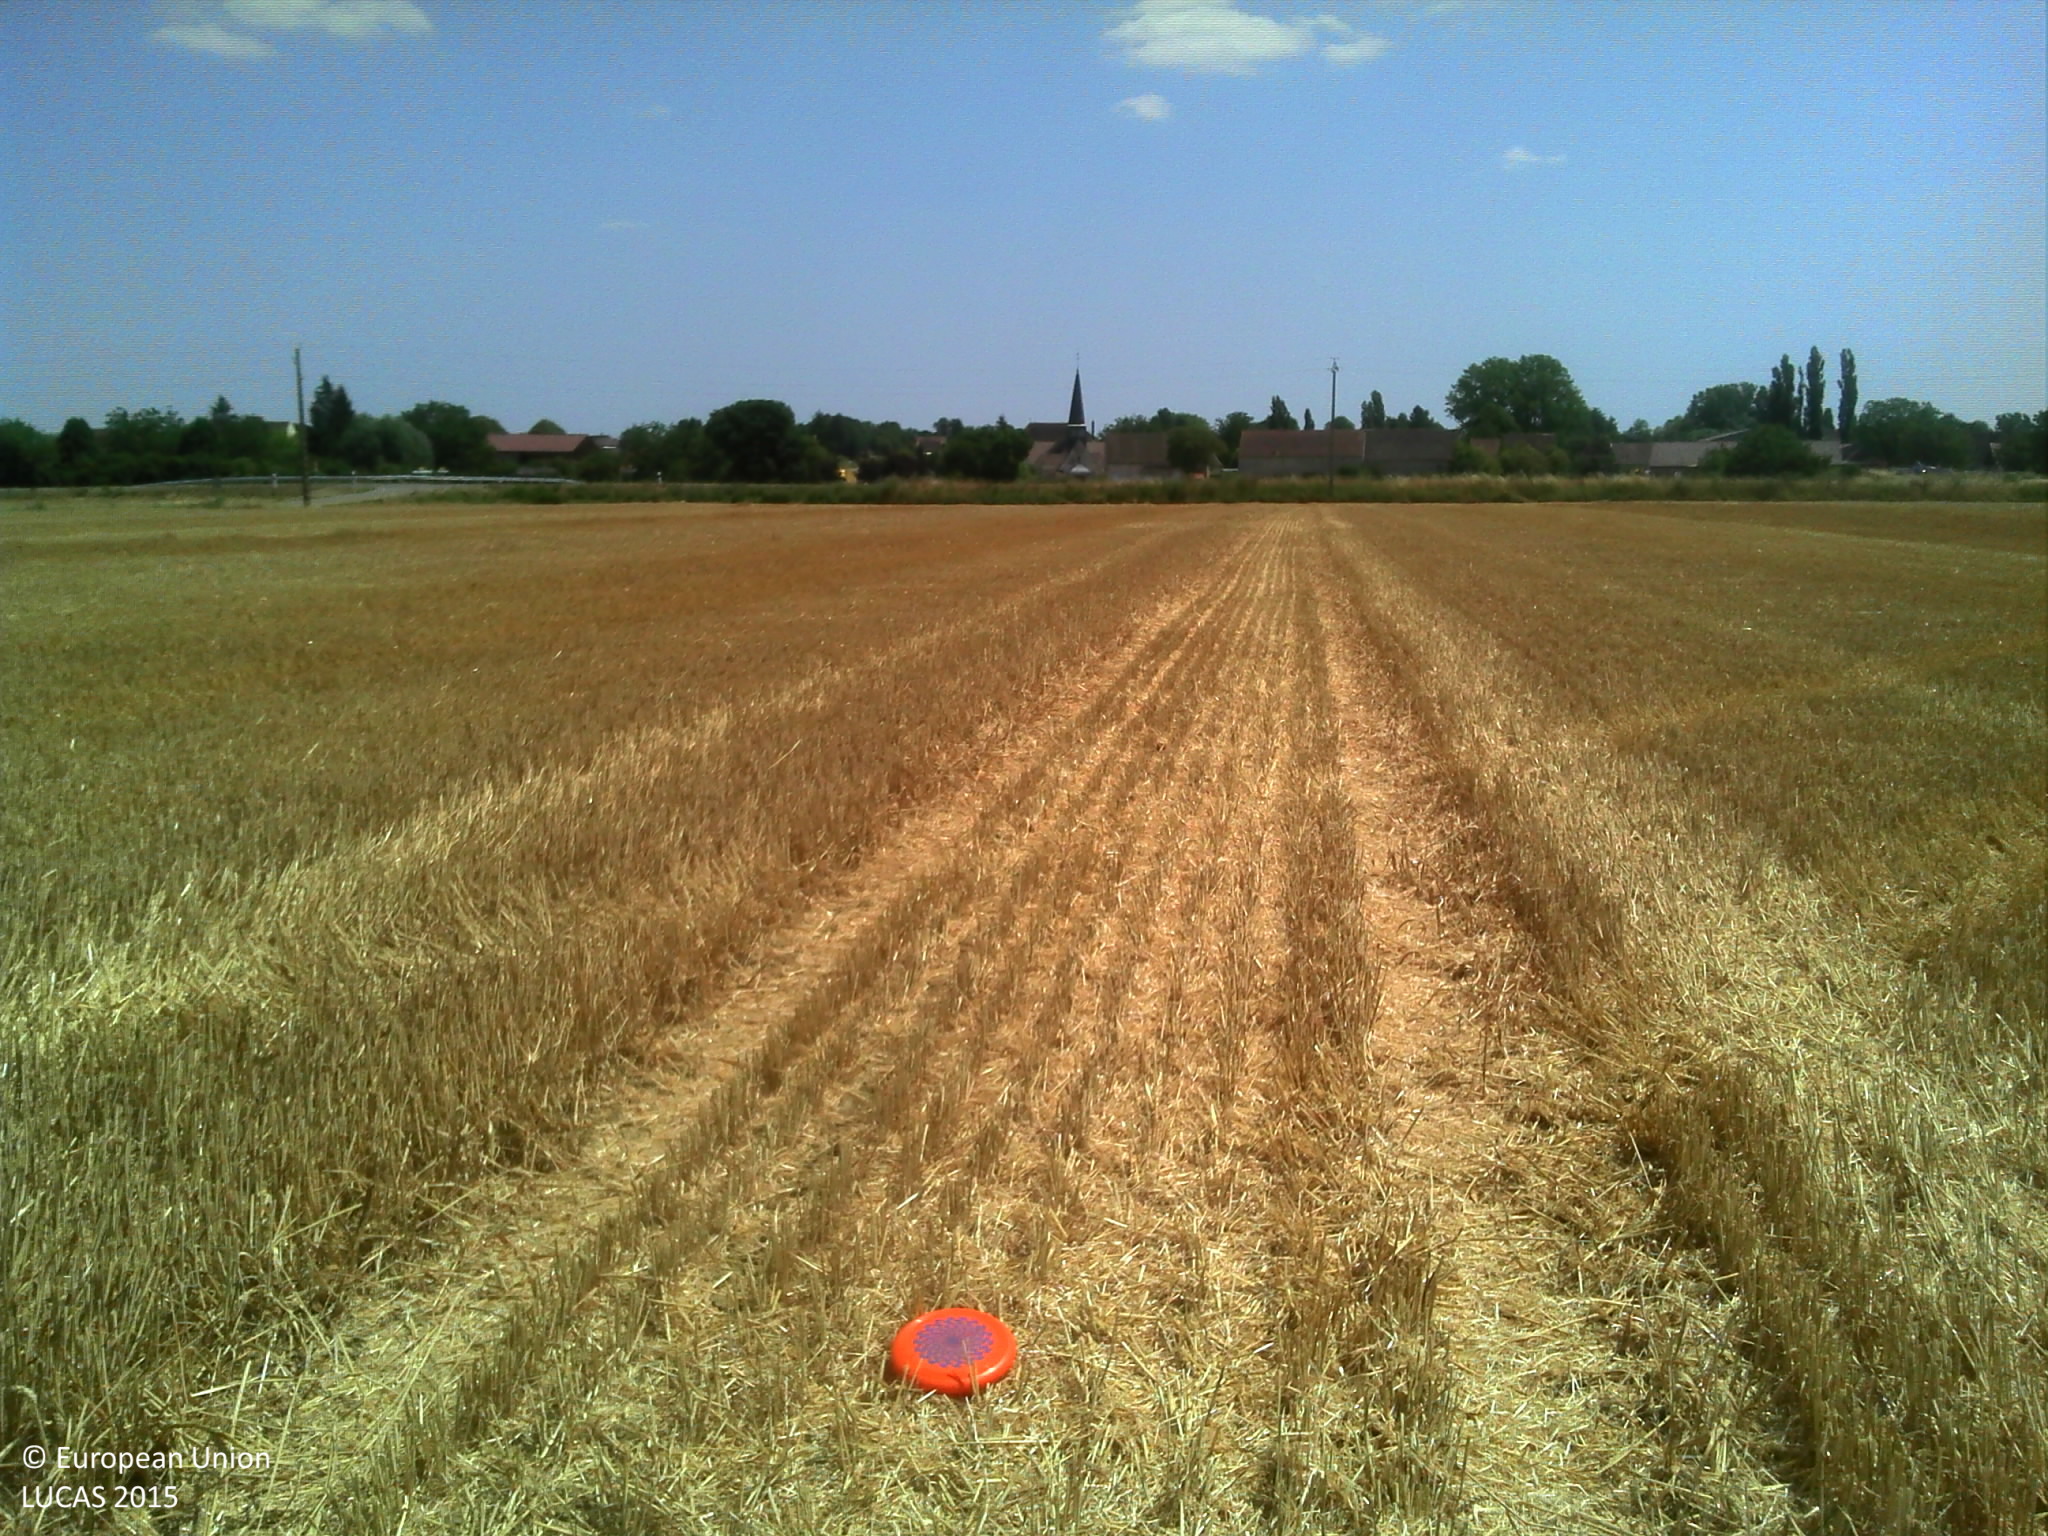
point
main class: Cropland
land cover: Common wheat
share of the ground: > 75 %
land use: Agriculture (excluding fallow land and kitchen gardens)
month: July
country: FR
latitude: 46.9055
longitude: 5.0784
